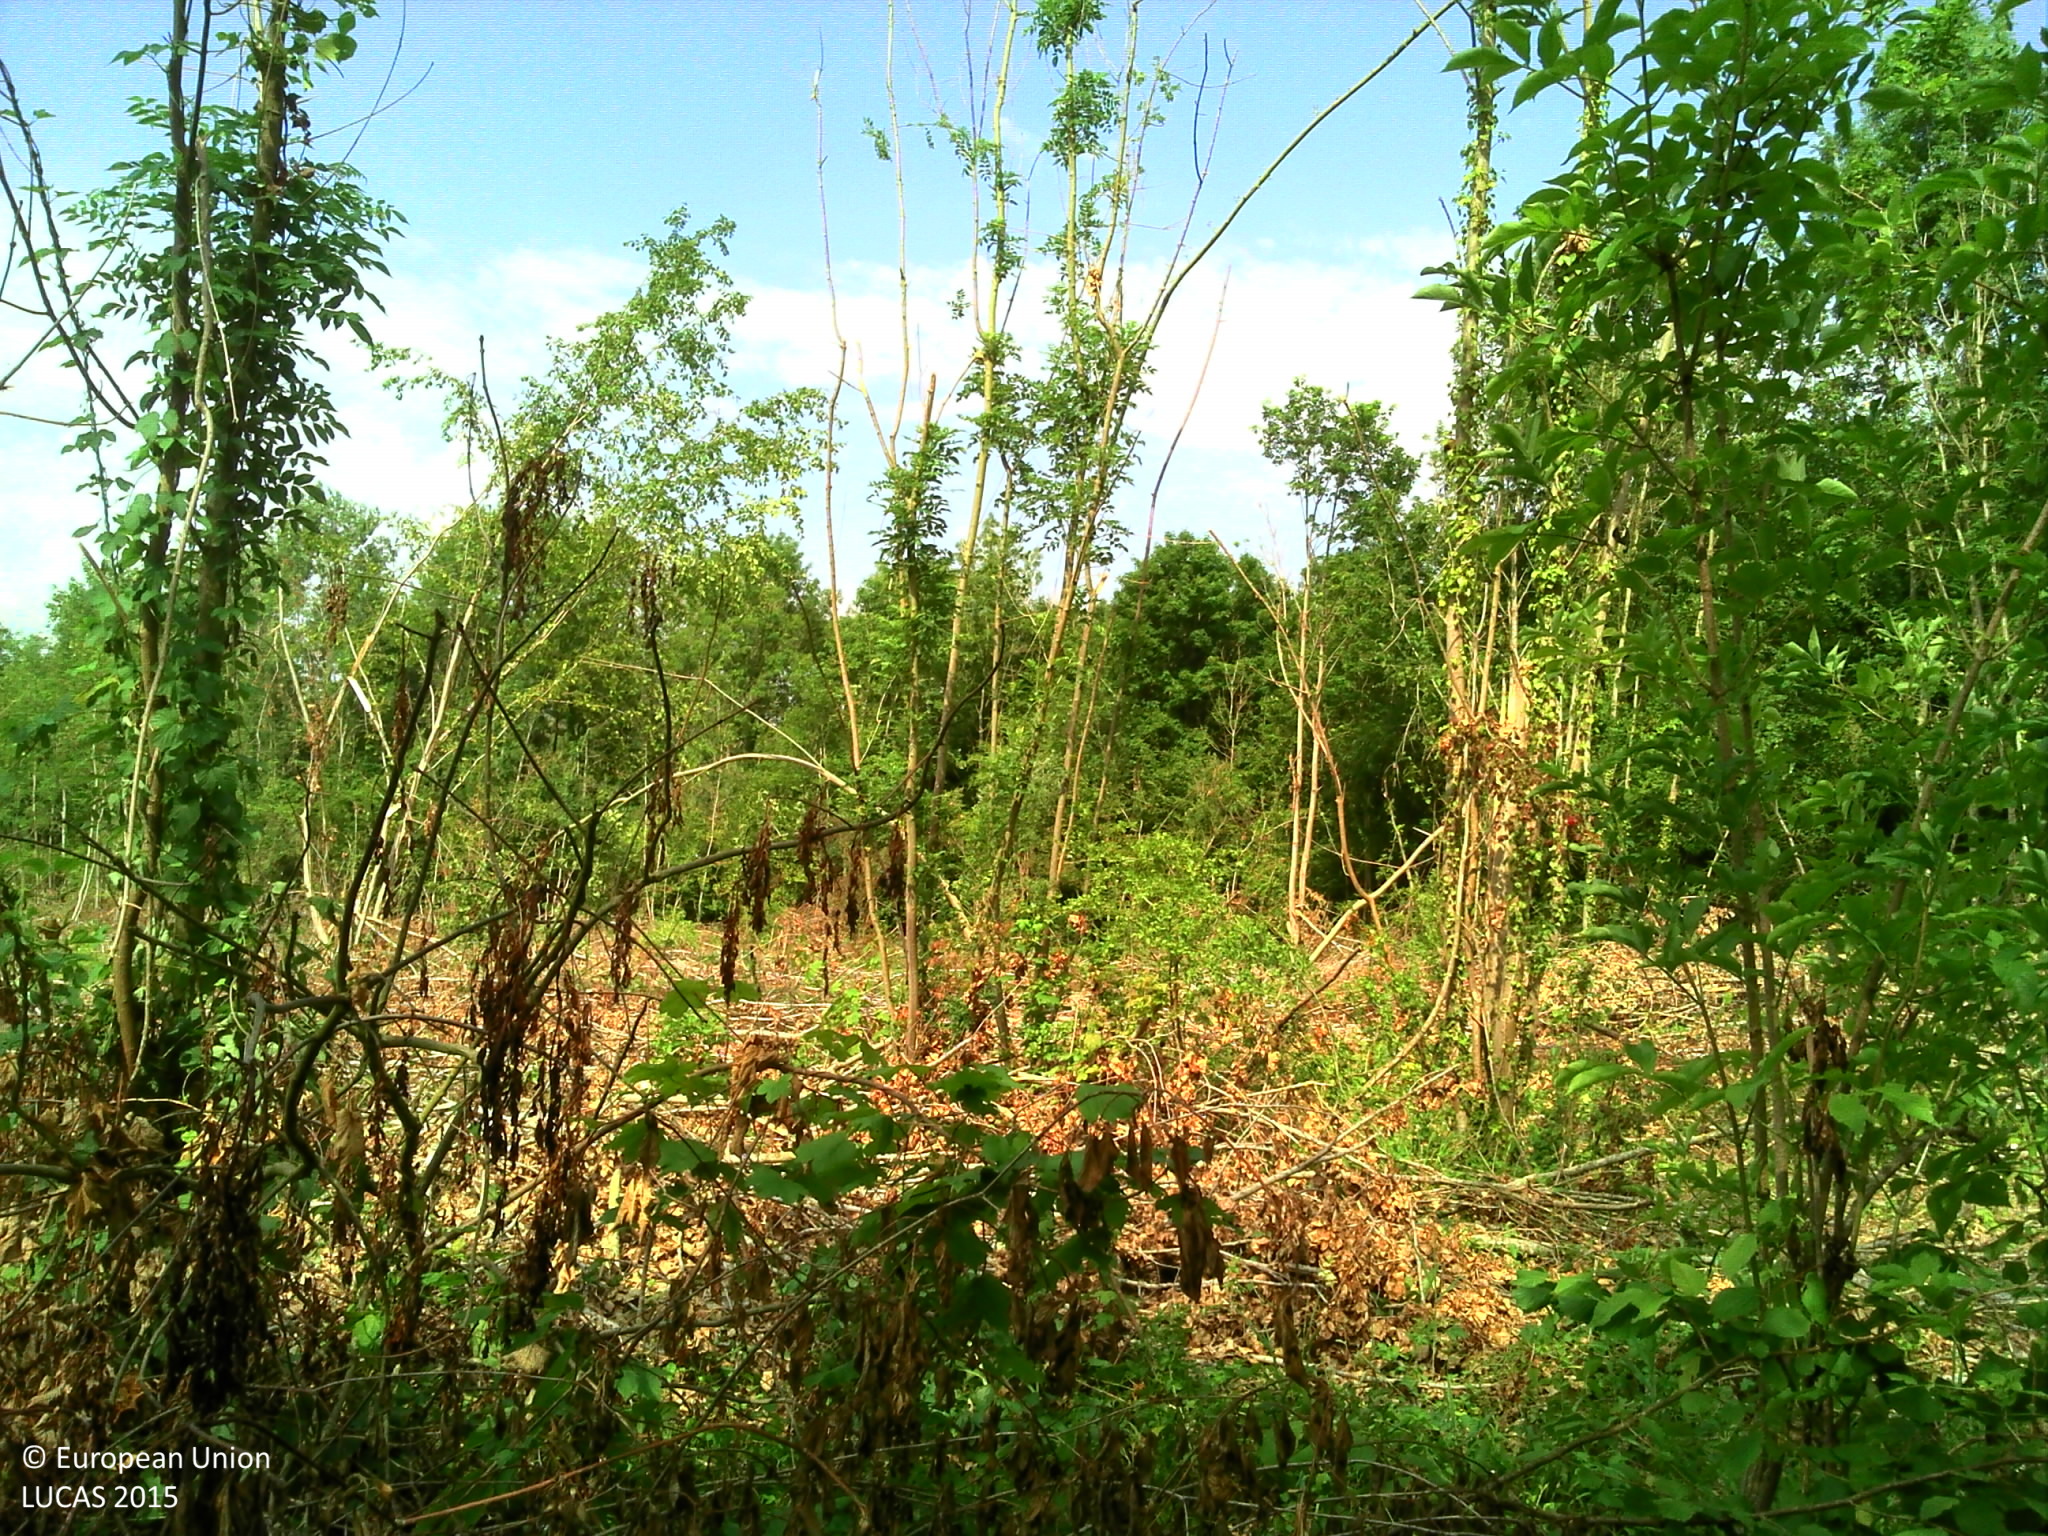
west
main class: Woodland
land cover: Broadleaved woodland
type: mesophytic deciduous forest
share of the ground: > 75 %
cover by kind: broadleaved forest trees 35 %, herbaceous plants 35 %, shrubs 30 %
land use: Forestry
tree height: > 5 m
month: July
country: FR
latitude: 49.3025
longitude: 2.4653
